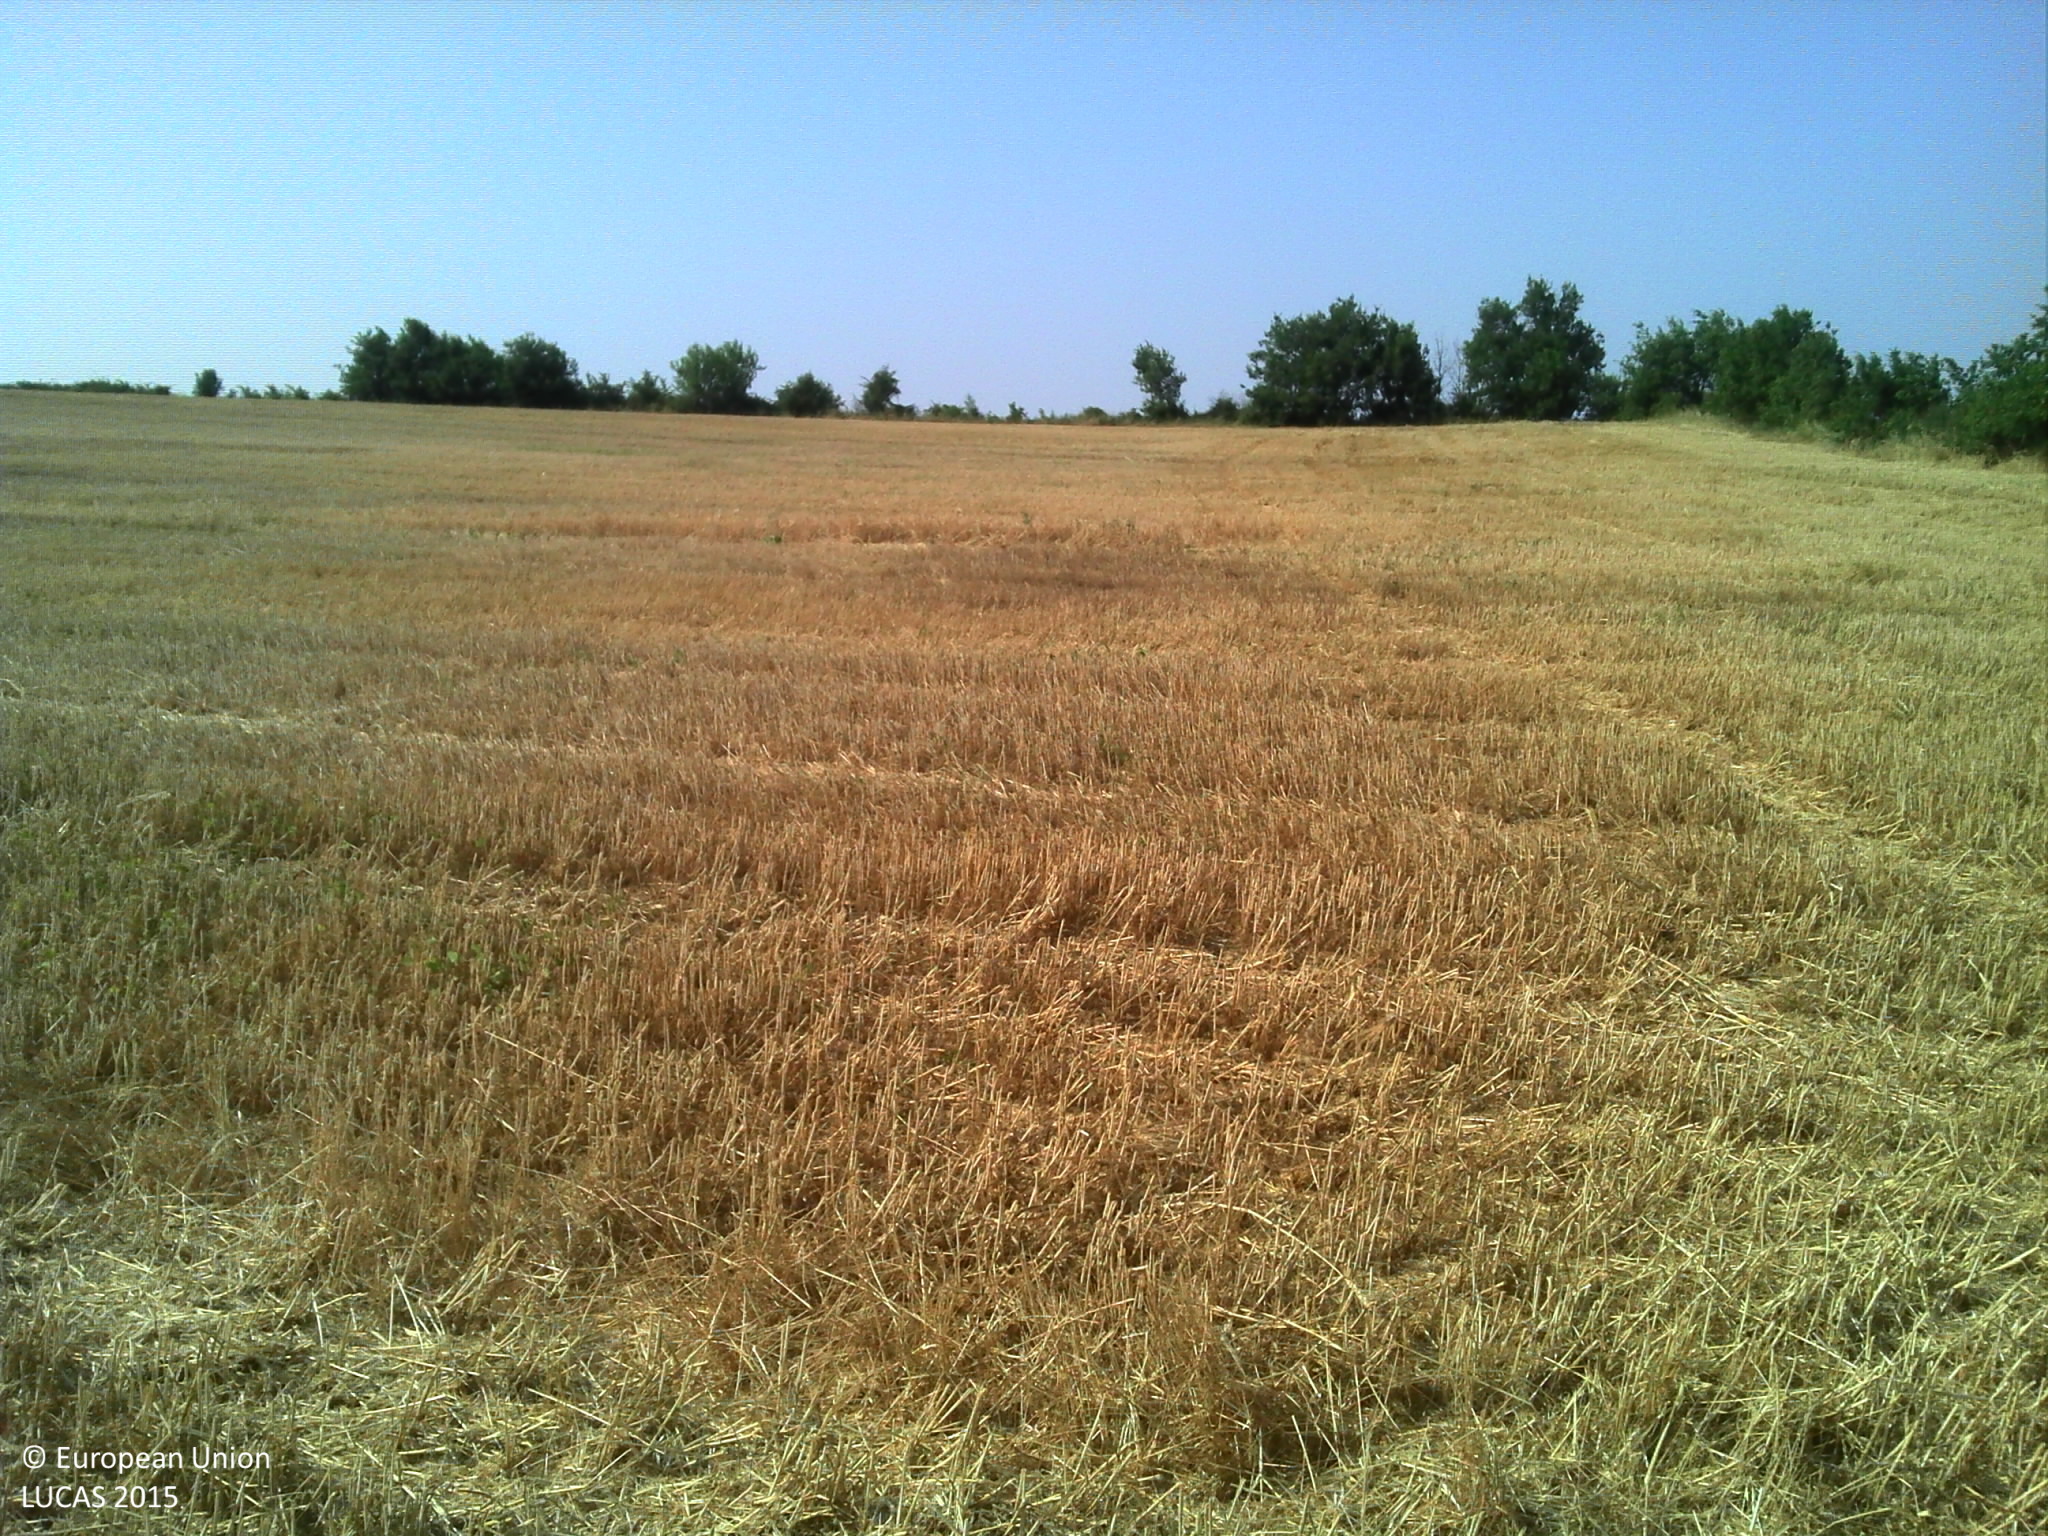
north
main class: Cropland
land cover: Durum wheat
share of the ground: > 75 %
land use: Agriculture (excluding fallow land and kitchen gardens)
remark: Harvested field
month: July
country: FR
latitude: 43.0912
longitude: 2.1334
